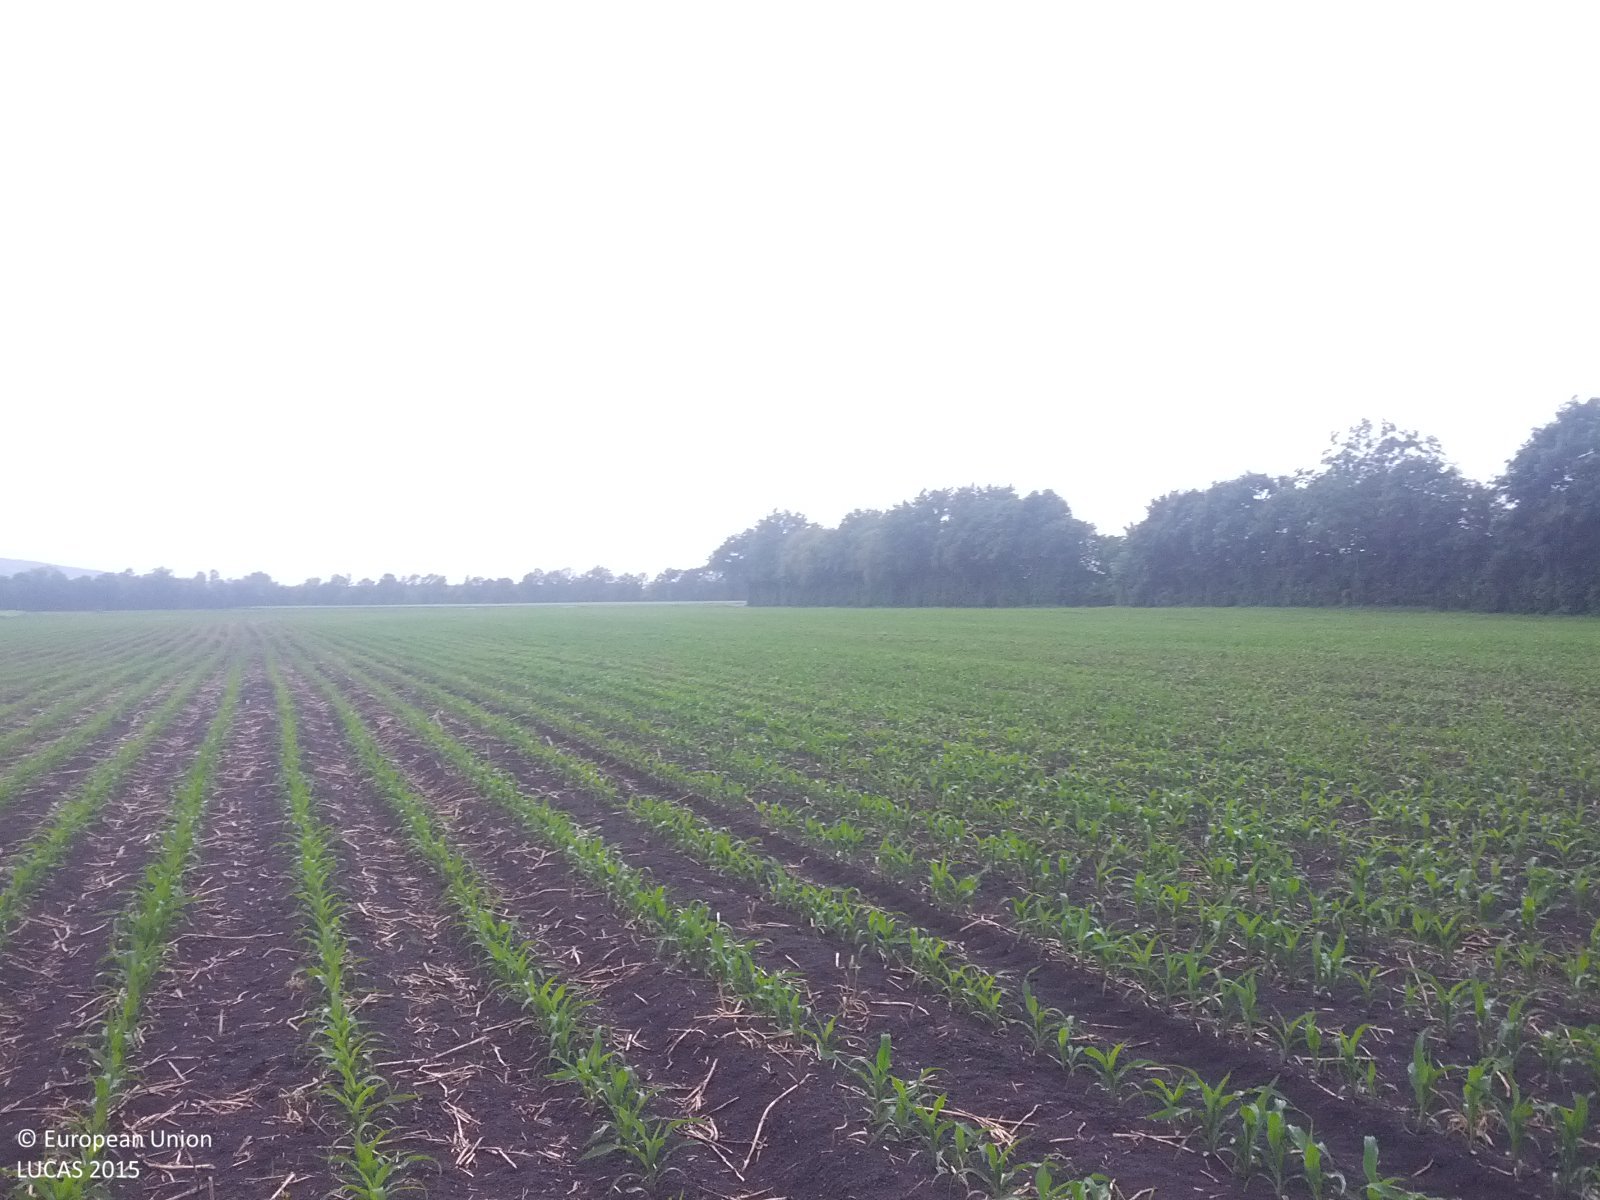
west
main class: Cropland
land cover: Maize
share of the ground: 10 - 25 %
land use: Agriculture (excluding fallow land and kitchen gardens)
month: May
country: AT
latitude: 48.3066
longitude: 16.1119
